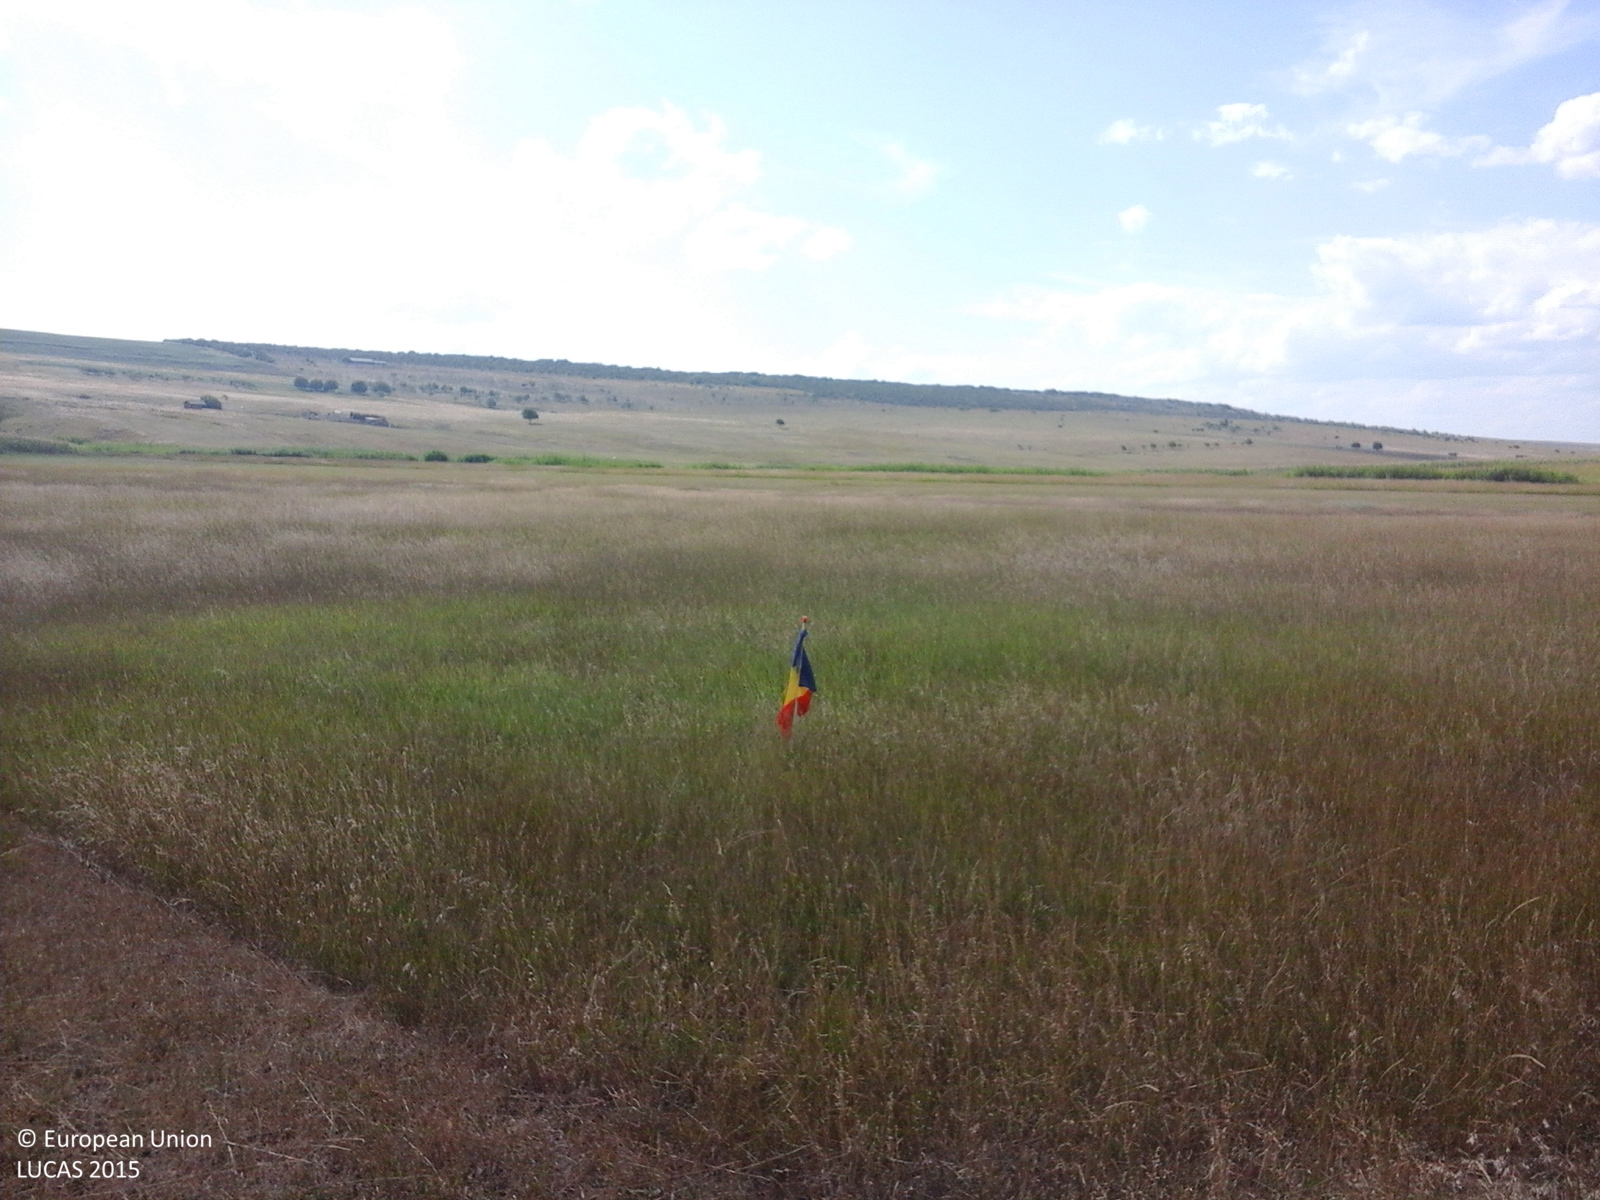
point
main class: Grassland
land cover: Grassland without tree/shrub cover
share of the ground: > 75 %
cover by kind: herbaceous plants 100 %
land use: Agriculture (excluding fallow land and kitchen gardens)
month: July
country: RO
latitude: 46.5009
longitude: 28.1256
